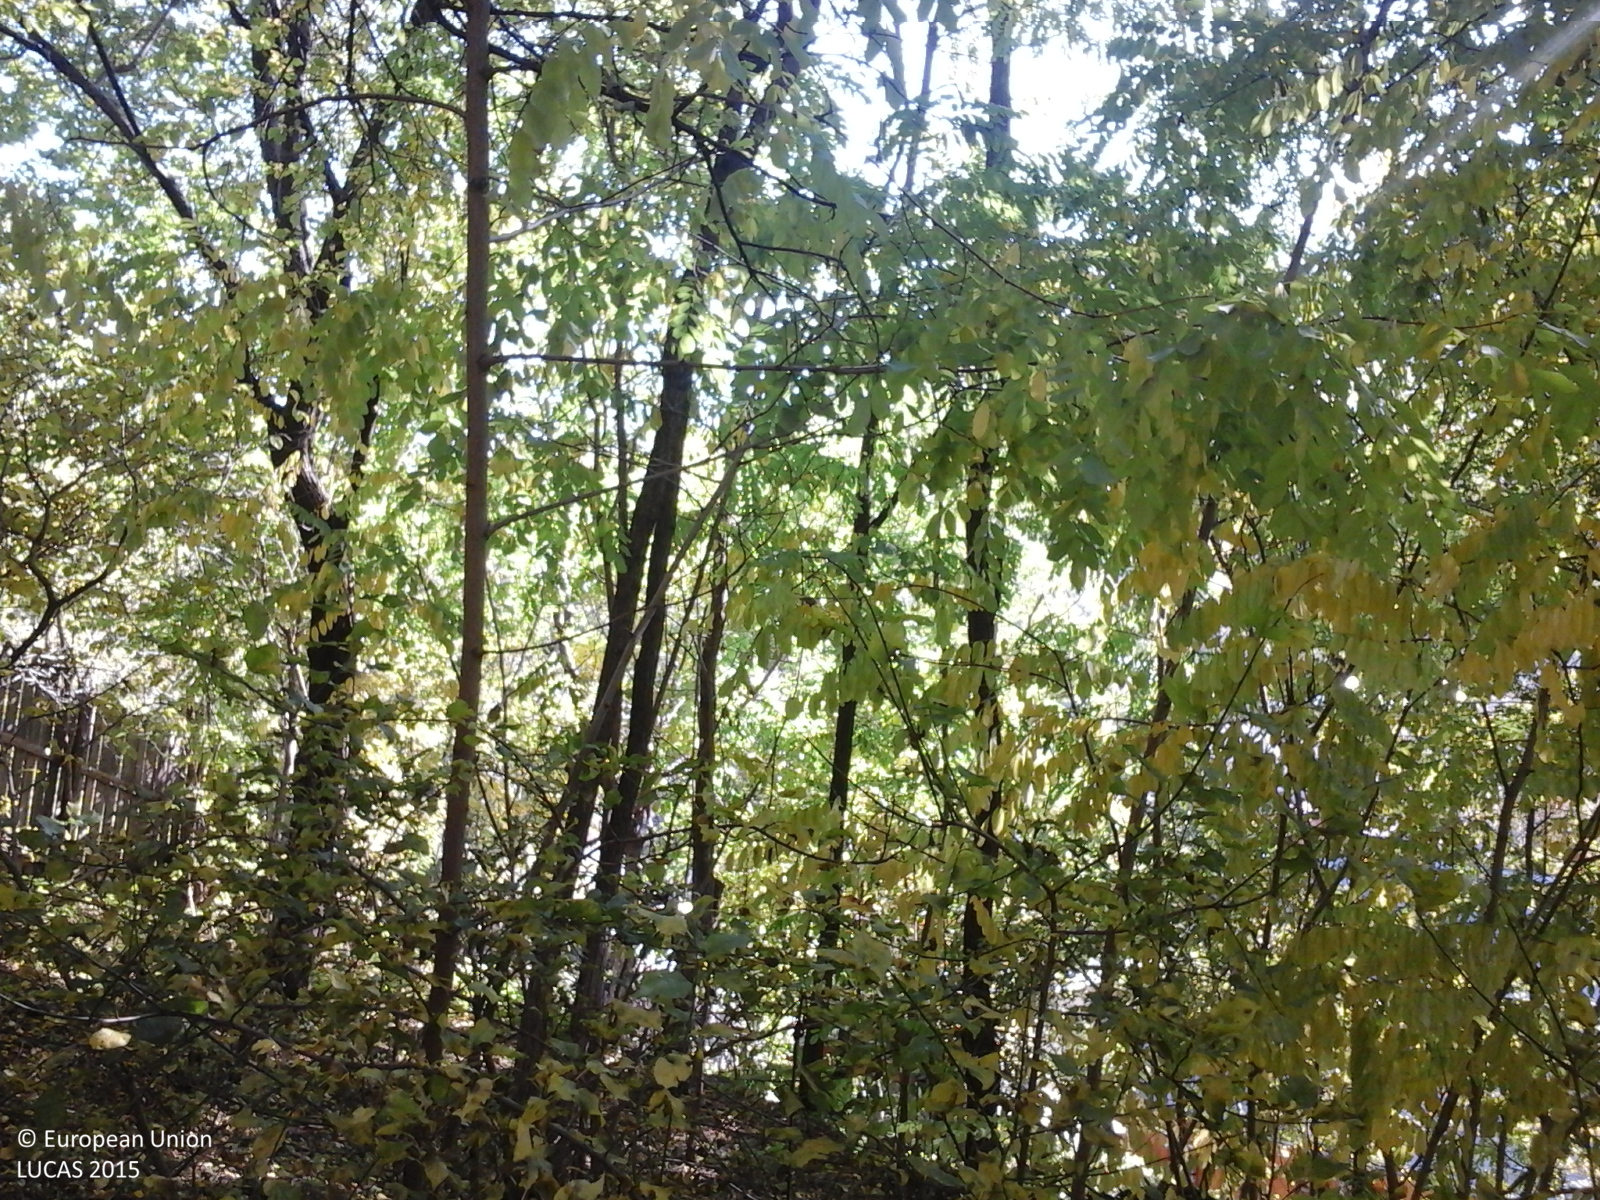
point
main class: Woodland
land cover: Broadleaved woodland
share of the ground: > 75 %
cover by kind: broadleaved forest trees 100 %
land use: Forestry
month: October
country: RO
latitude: 45.4844
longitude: 26.5939
